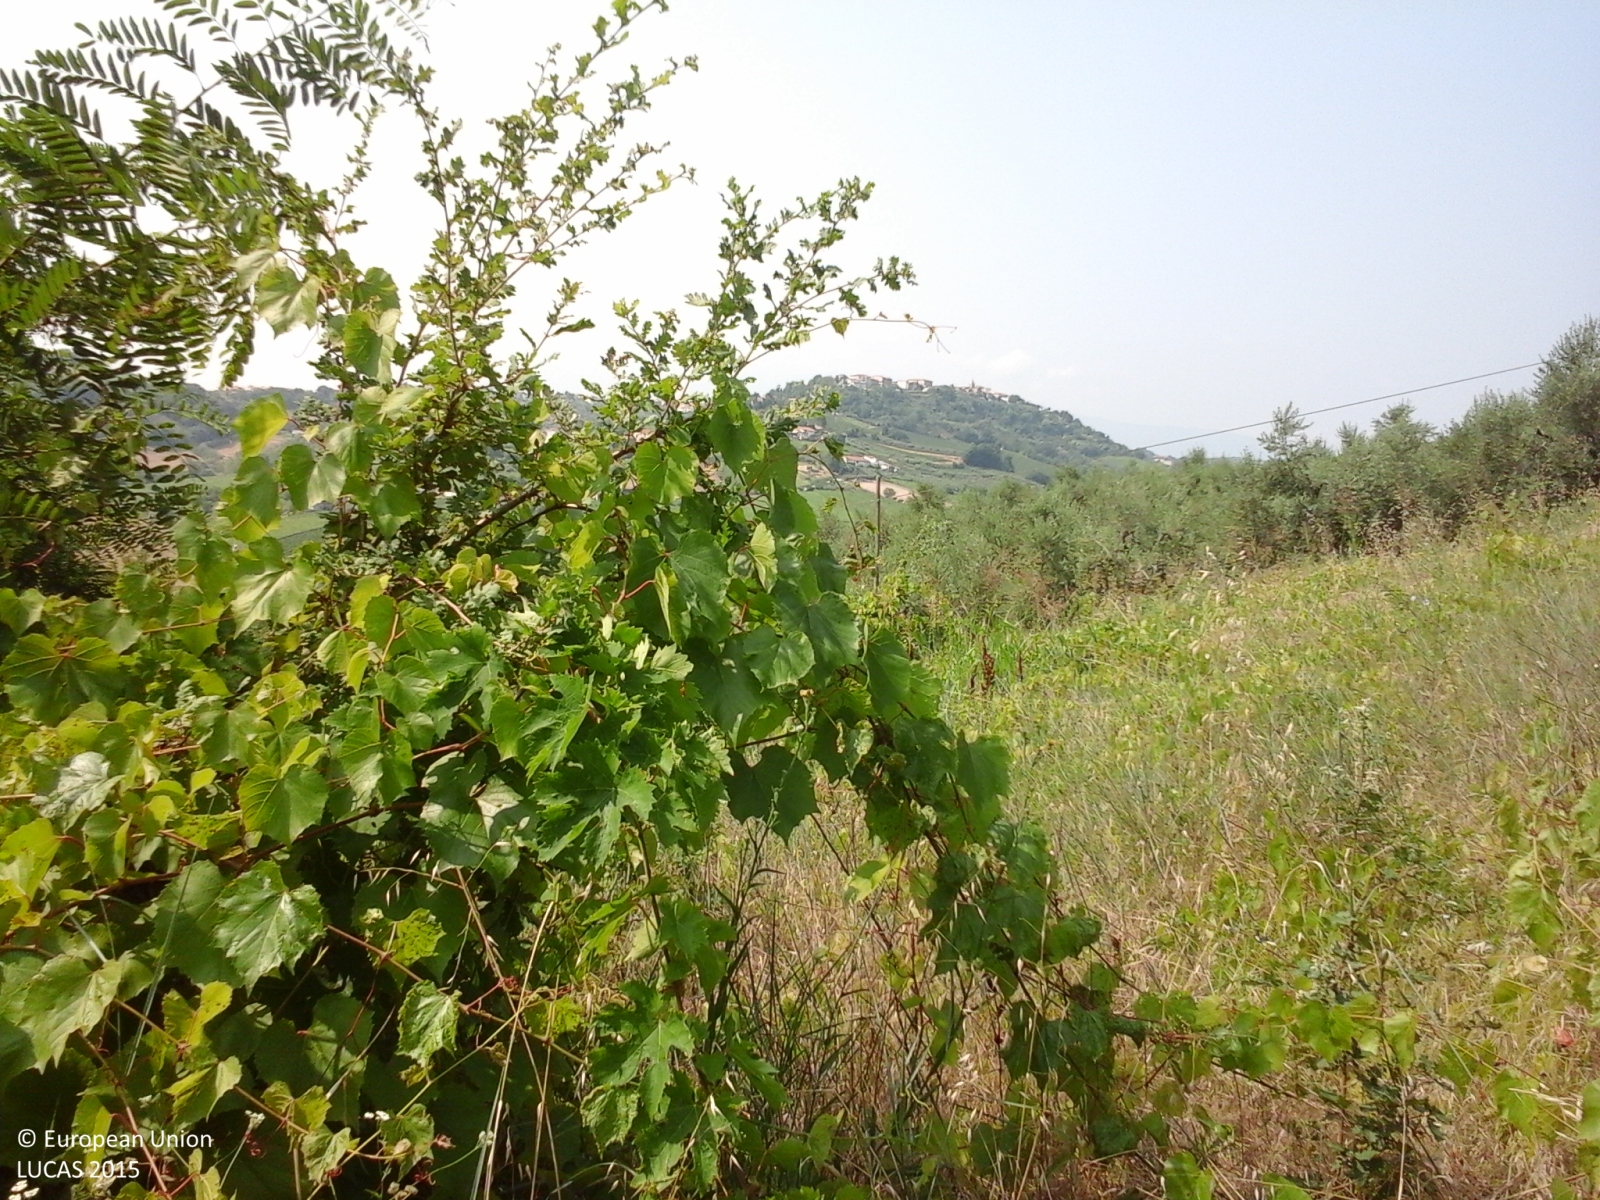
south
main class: Shrubland
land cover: Shrubland with sparse tree cover
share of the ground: 50 - 75 %
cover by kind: shrubs 90 %, broadleaved forest trees 5 %, herbaceous plants 5 %
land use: Abandoned areas
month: July
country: IT
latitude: 42.3479
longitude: 14.2480
